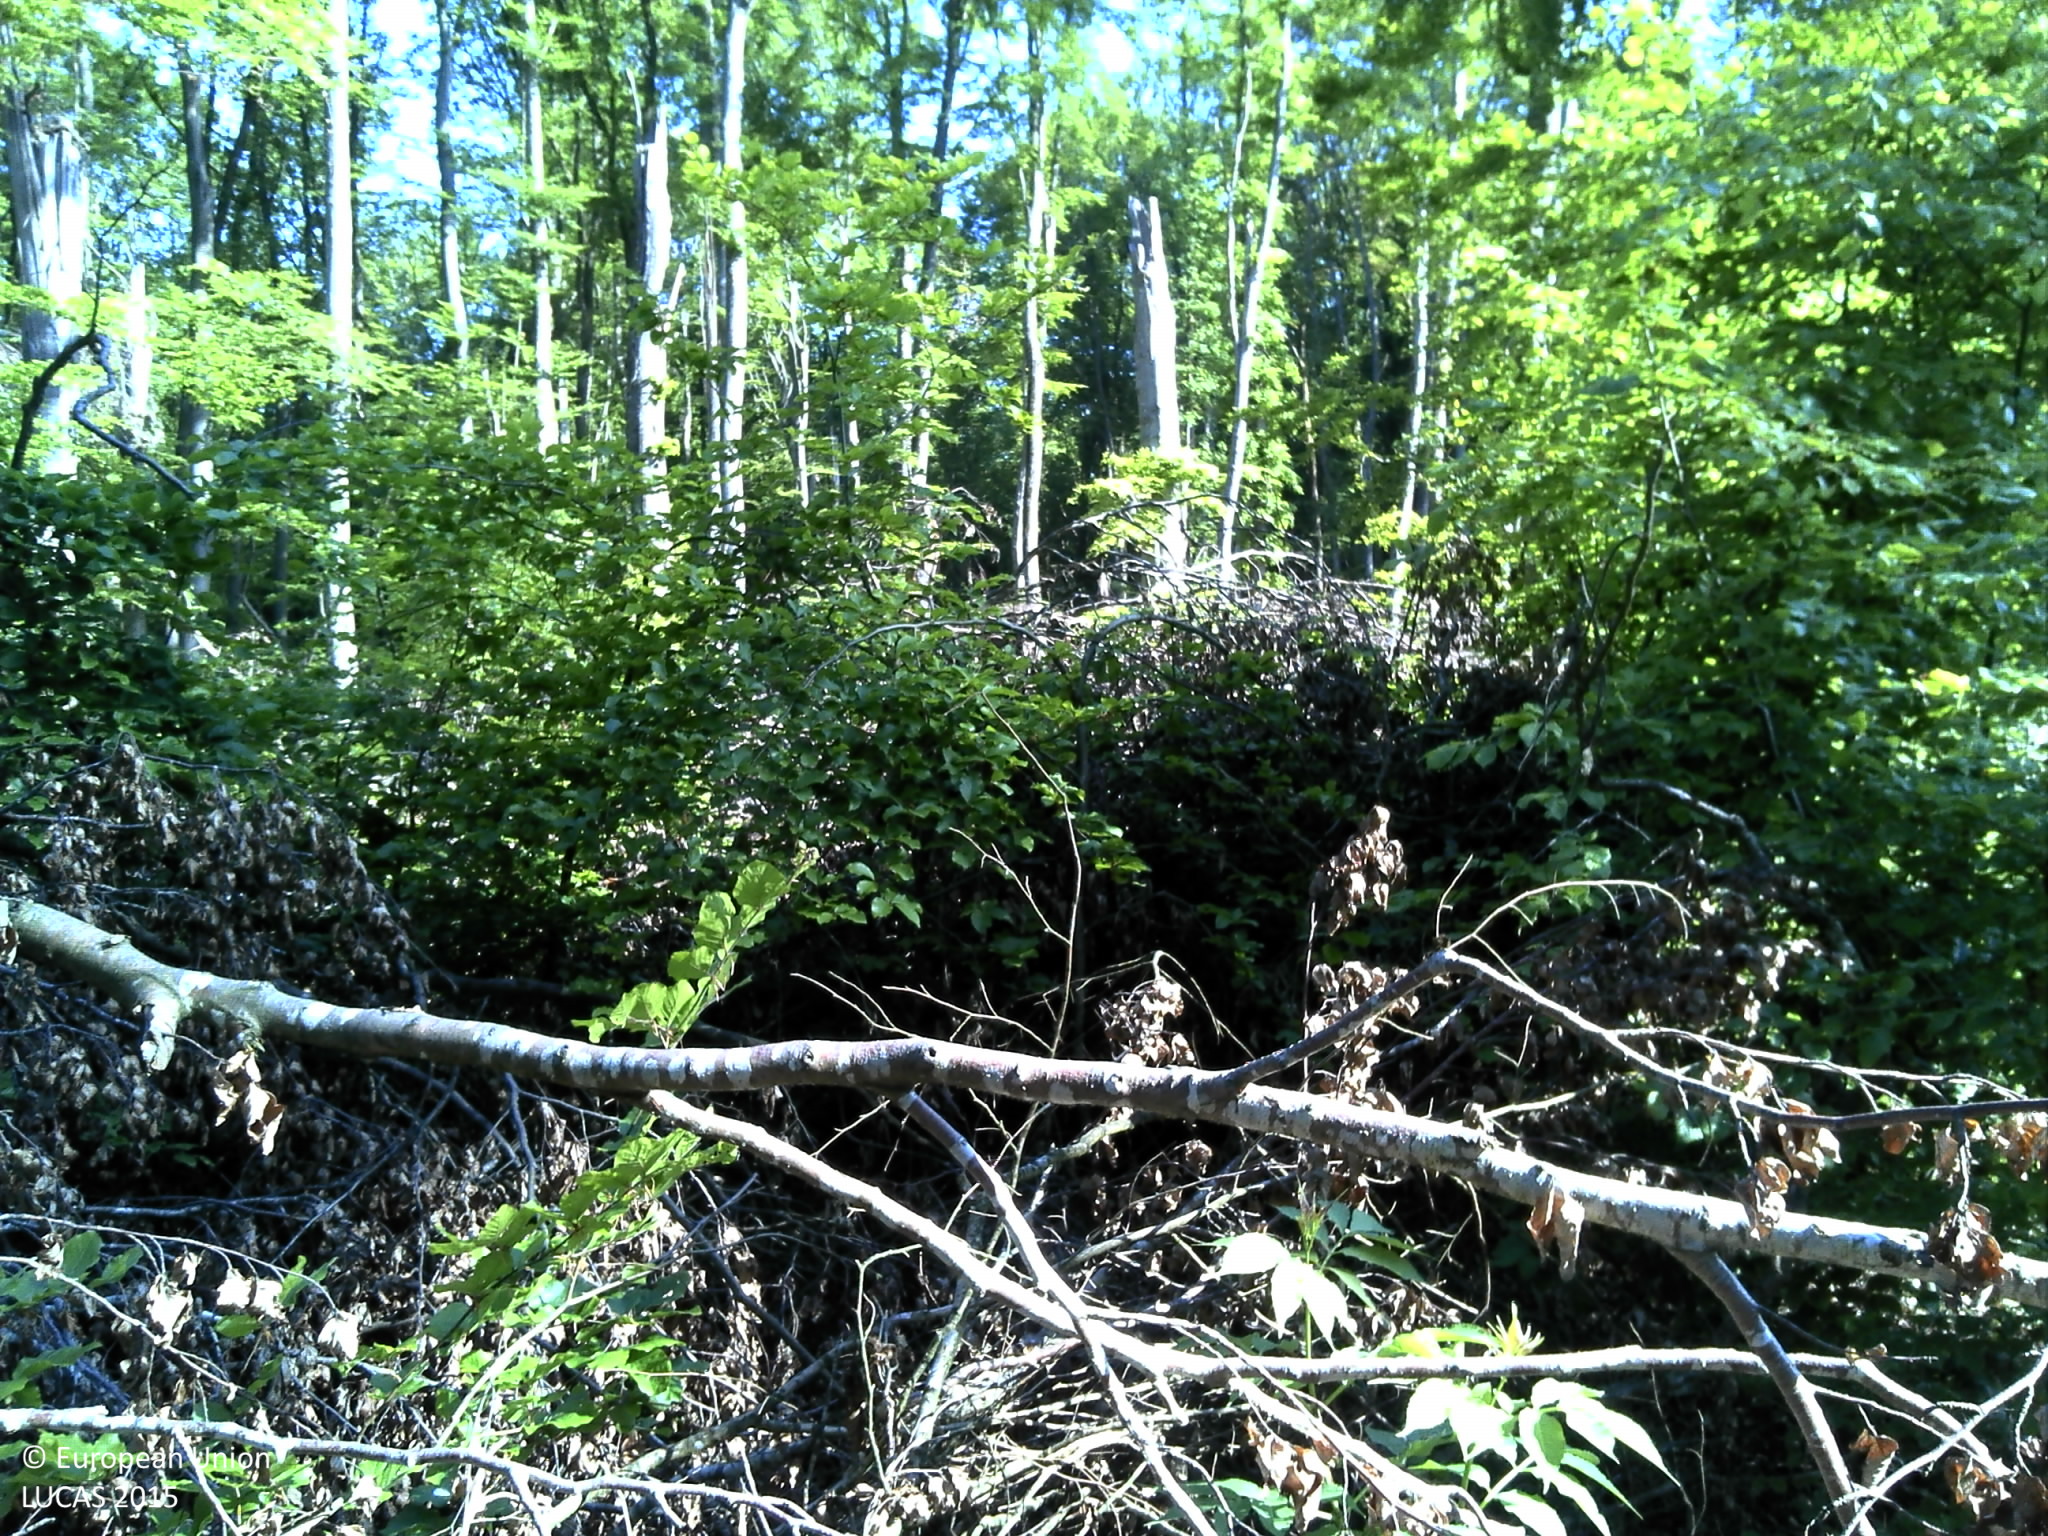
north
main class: Woodland
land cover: Broadleaved woodland
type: beech forest
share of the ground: > 75 %
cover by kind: broadleaved forest trees 100 %
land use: Forestry
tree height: > 5 m
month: May
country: LU
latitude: 49.6808
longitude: 5.9661
